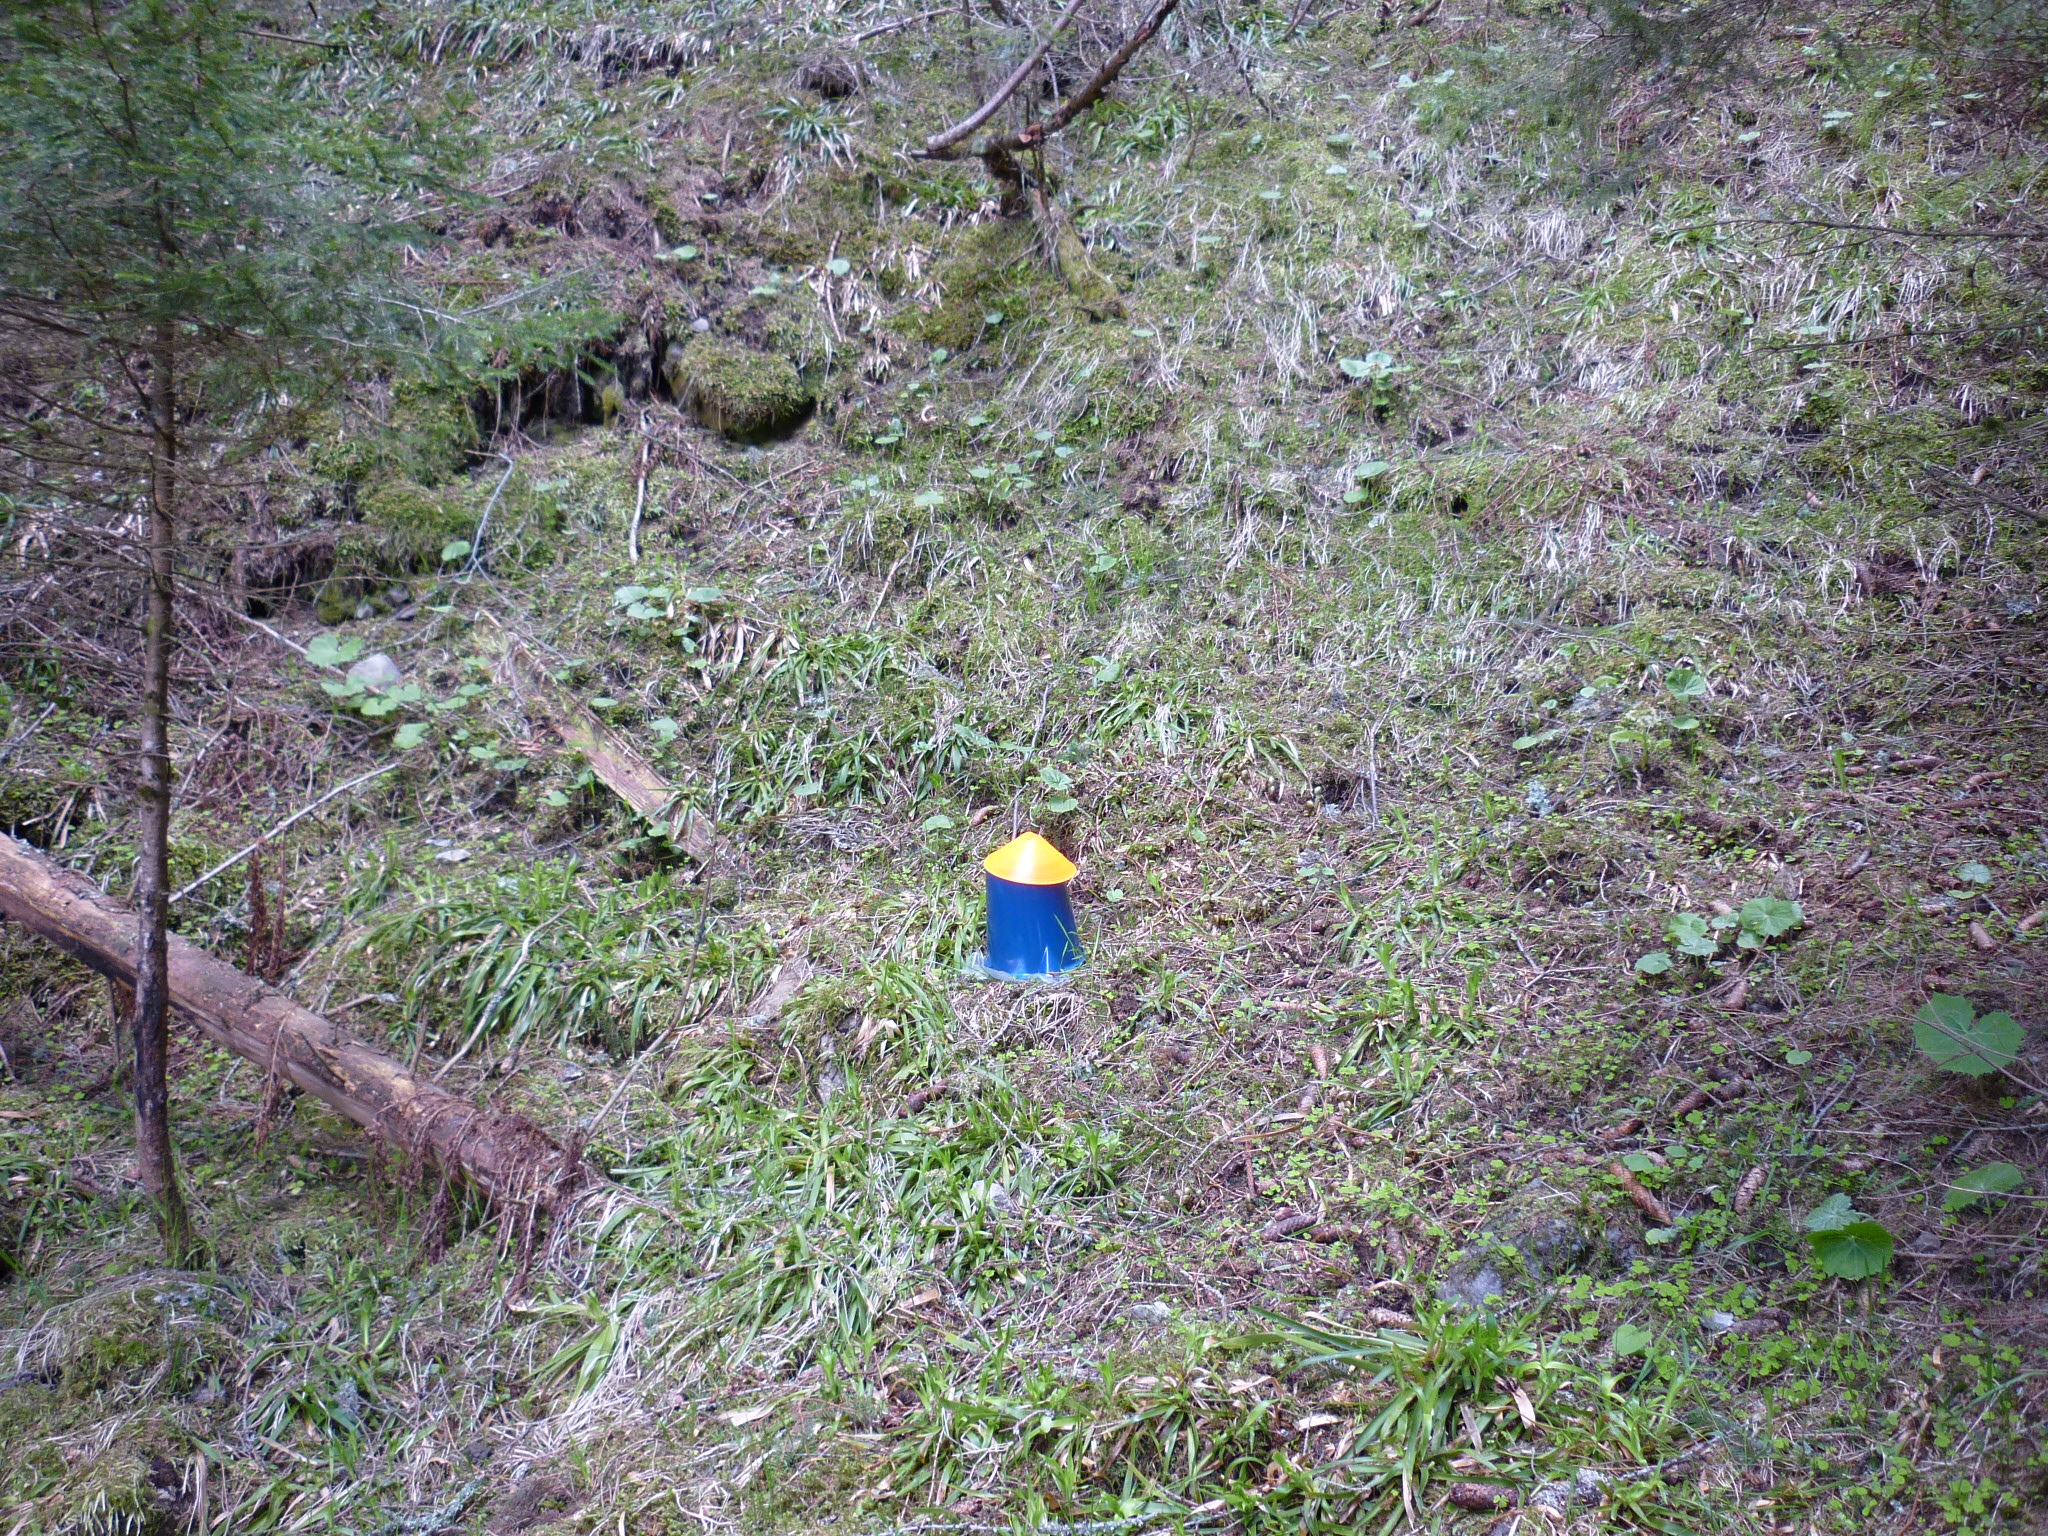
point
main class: Grassland
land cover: Grassland with sparse tree/shrub cover
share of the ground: > 75 %
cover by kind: herbaceous plants 90 %, coniferous forest trees 5 %, lichens and mosses 5 %
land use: Forestry
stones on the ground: 10 - 25 %
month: May
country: AT
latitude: 47.5062
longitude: 14.3671
